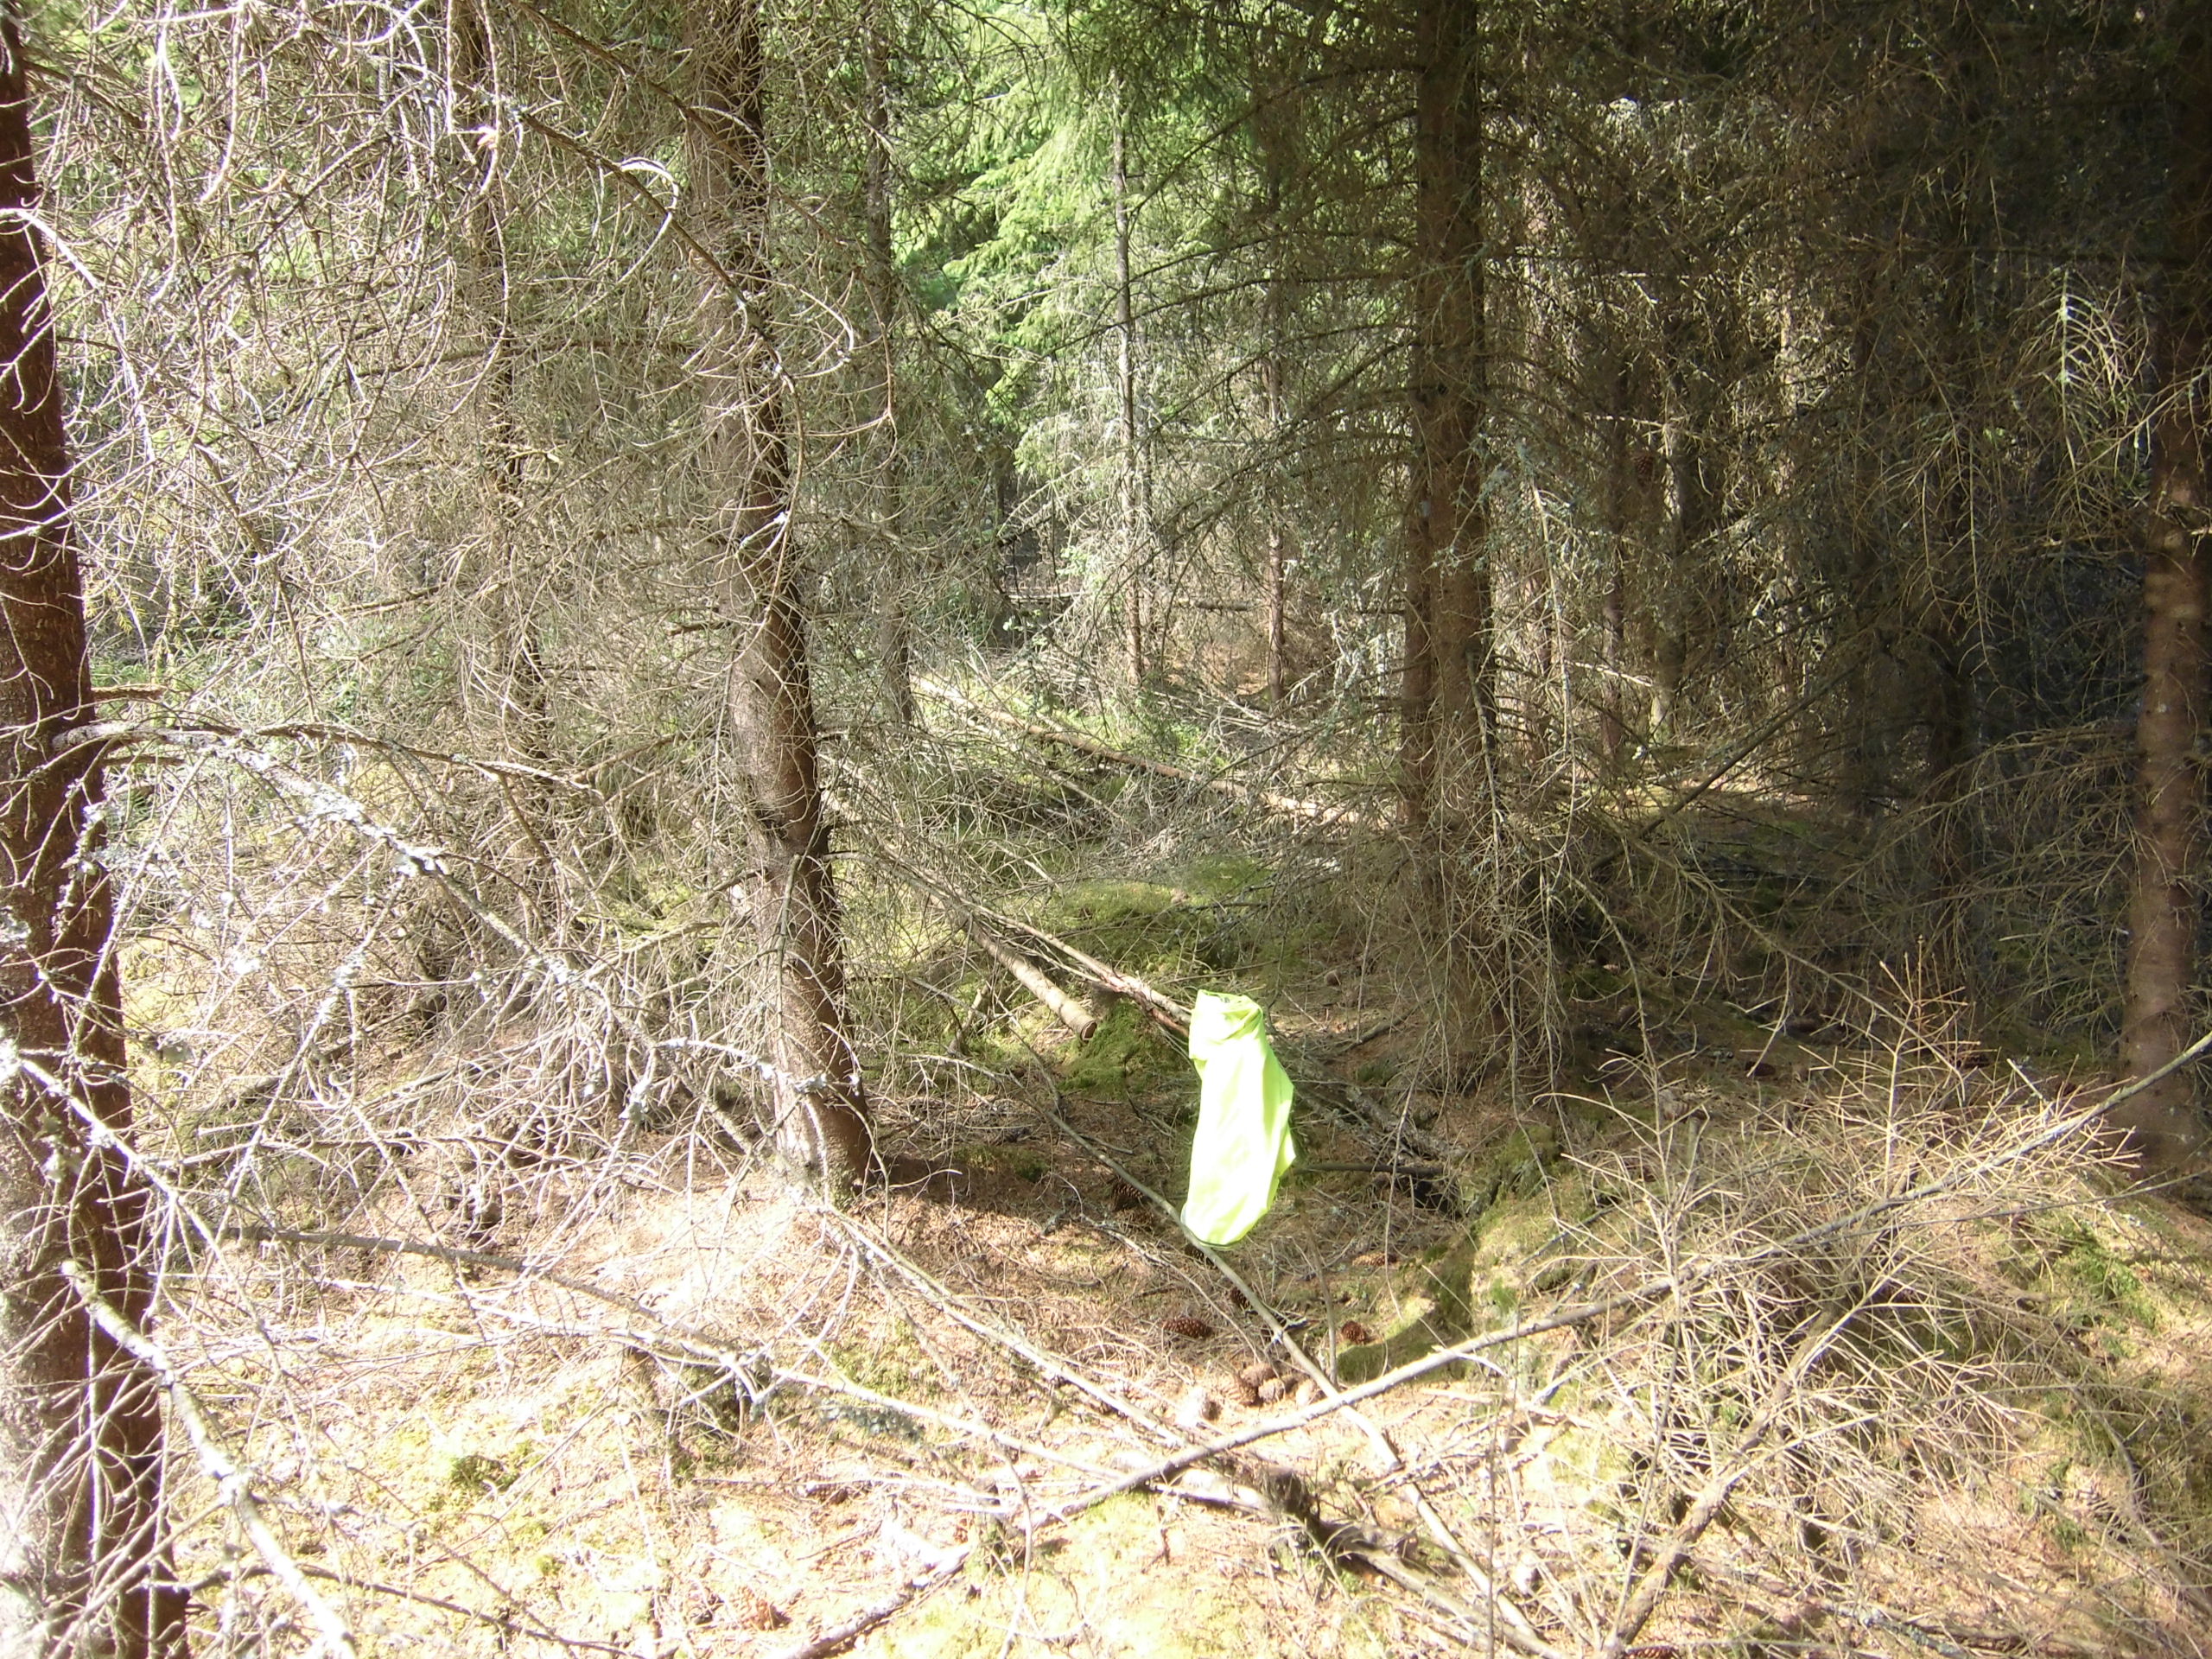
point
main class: Woodland
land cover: Spruce dominated coniferous woodland
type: boreal forest
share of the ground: > 75 %
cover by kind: coniferous forest trees 75 %, lichens and mosses 10 %, unconsolidated bare surface 10 %, broadleaved forest trees 5 %
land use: Forestry
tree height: > 5 m
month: July
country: SE
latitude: 57.3325
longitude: 14.5309
